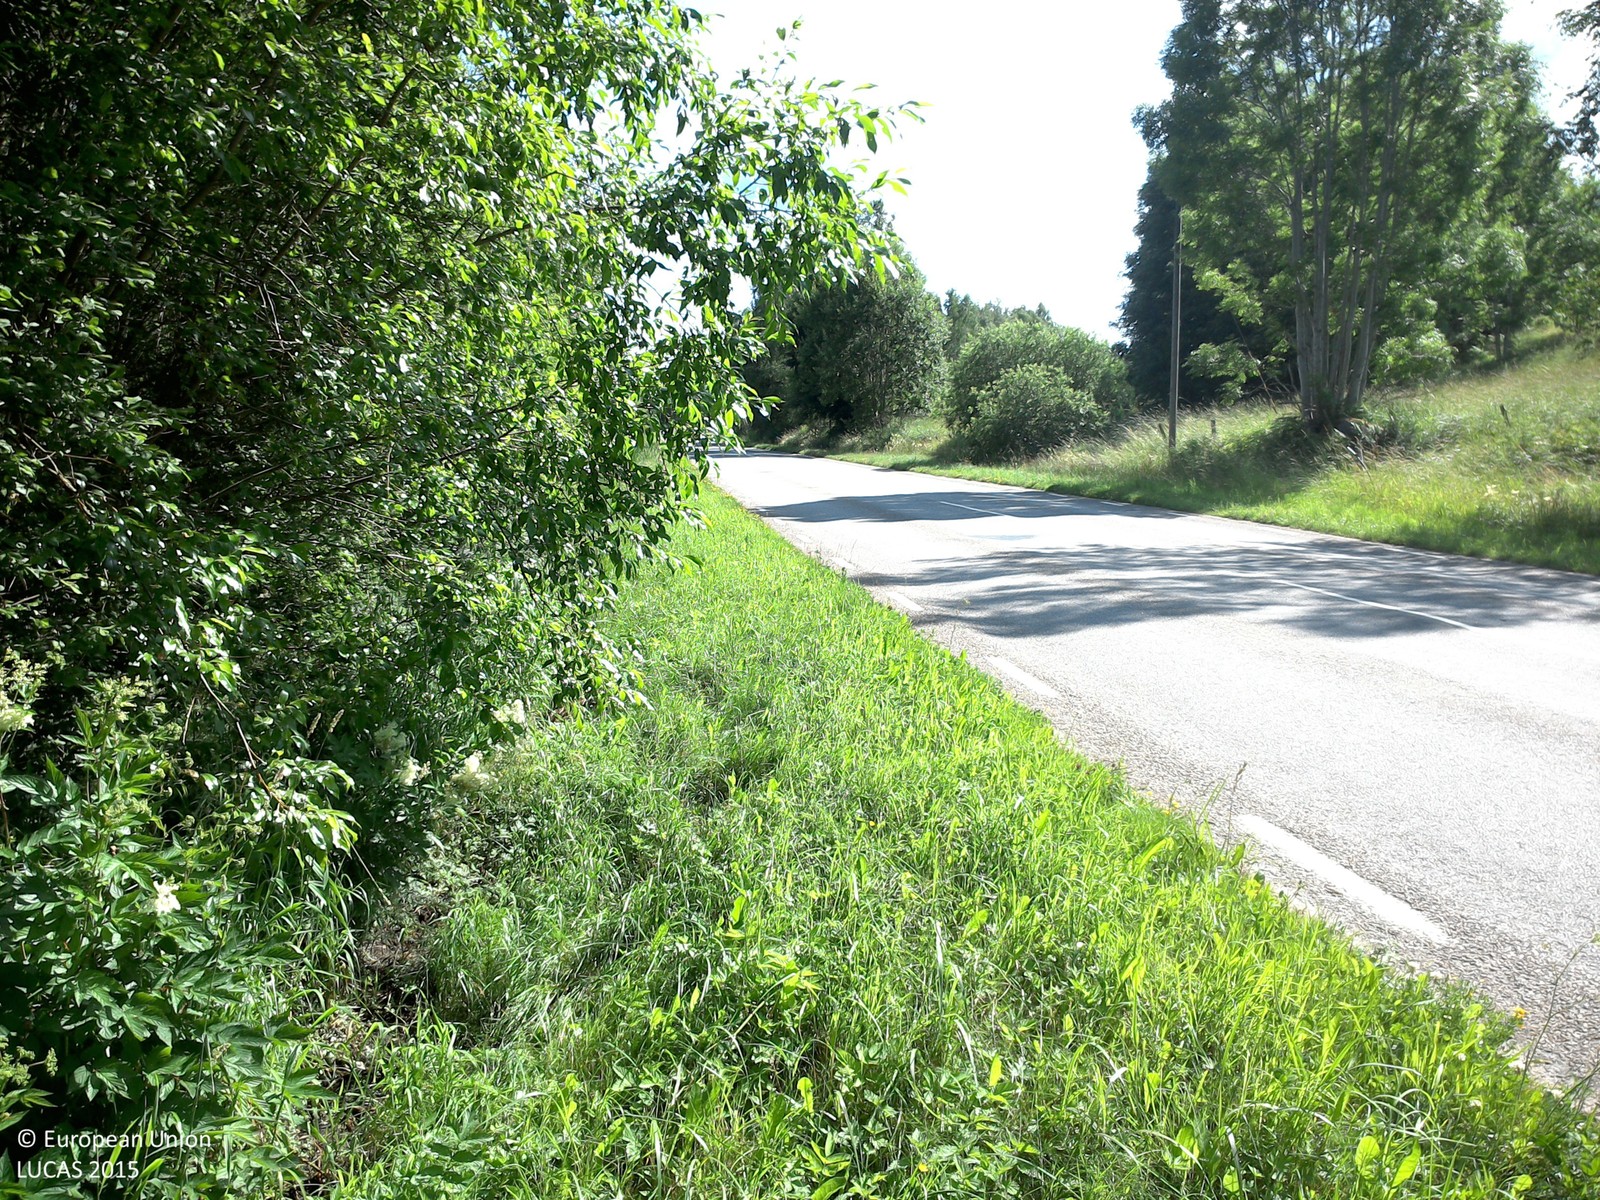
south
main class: Grassland
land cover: Grassland without tree/shrub cover
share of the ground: > 75 %
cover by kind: herbaceous plants 100 %
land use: Road transport
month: July
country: SE
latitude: 58.1362
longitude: 14.7329
